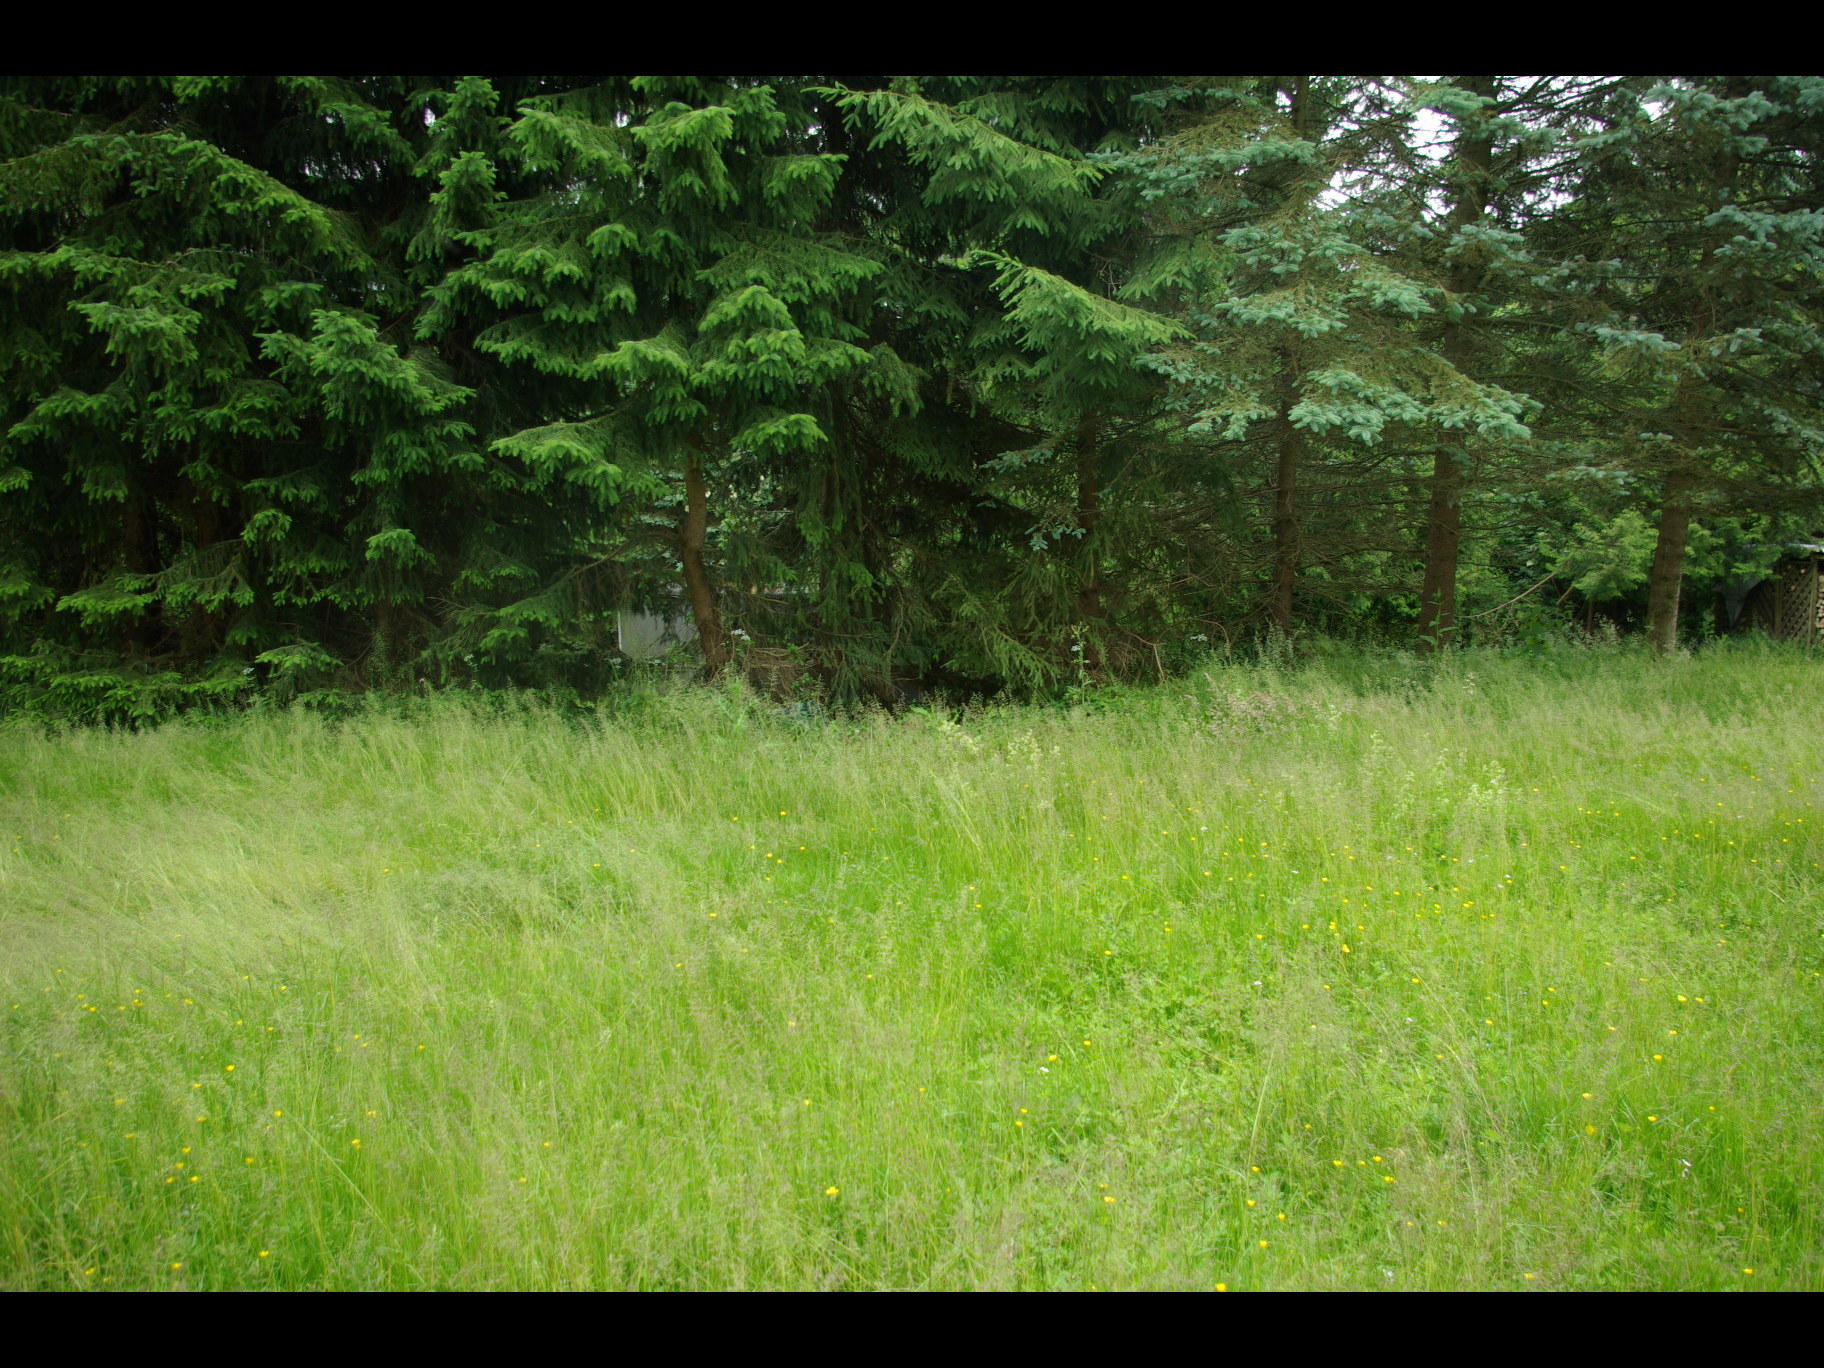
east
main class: Grassland
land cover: Grassland without tree/shrub cover
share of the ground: > 75 %
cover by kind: herbaceous plants 95 %, shrubs 5 %
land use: Residential
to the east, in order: Grassland without tree/shrub cover; Spruce dominated coniferous woodland; Grassland without tree/shrub cover; Other coniferous woodland; Grassland without tree/shrub cover; Broadleaved woodland; Artificial constructions in urban areas
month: June
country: DE
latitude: 54.4622
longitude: 9.8304
